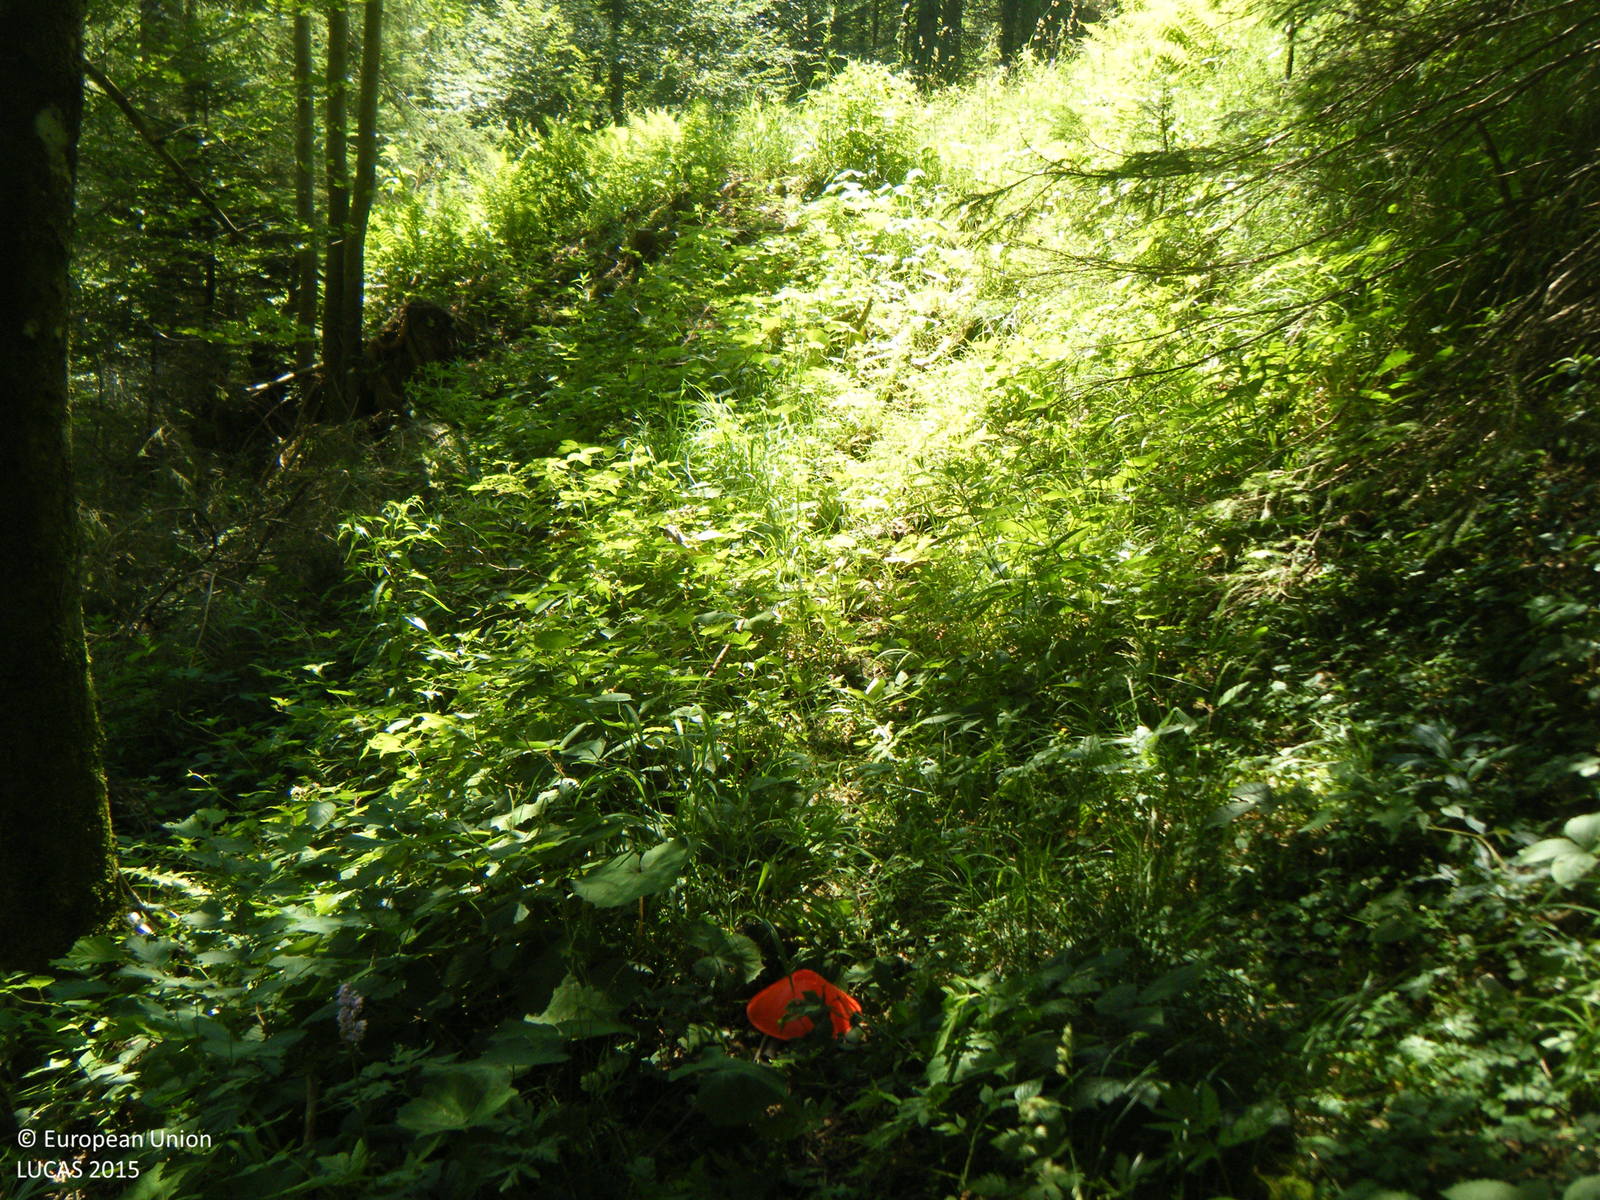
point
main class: Woodland
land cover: Spruce dominated mixed woodland
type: alpine coniferous forest
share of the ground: > 75 %
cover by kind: coniferous forest trees 60 %, broadleaved forest trees 25 %, herbaceous plants 15 %
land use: Forestry
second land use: Agriculture (excluding fallow land and kitchen gardens)
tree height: > 5 m
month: July
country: AT
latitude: 47.7593
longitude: 13.3205
